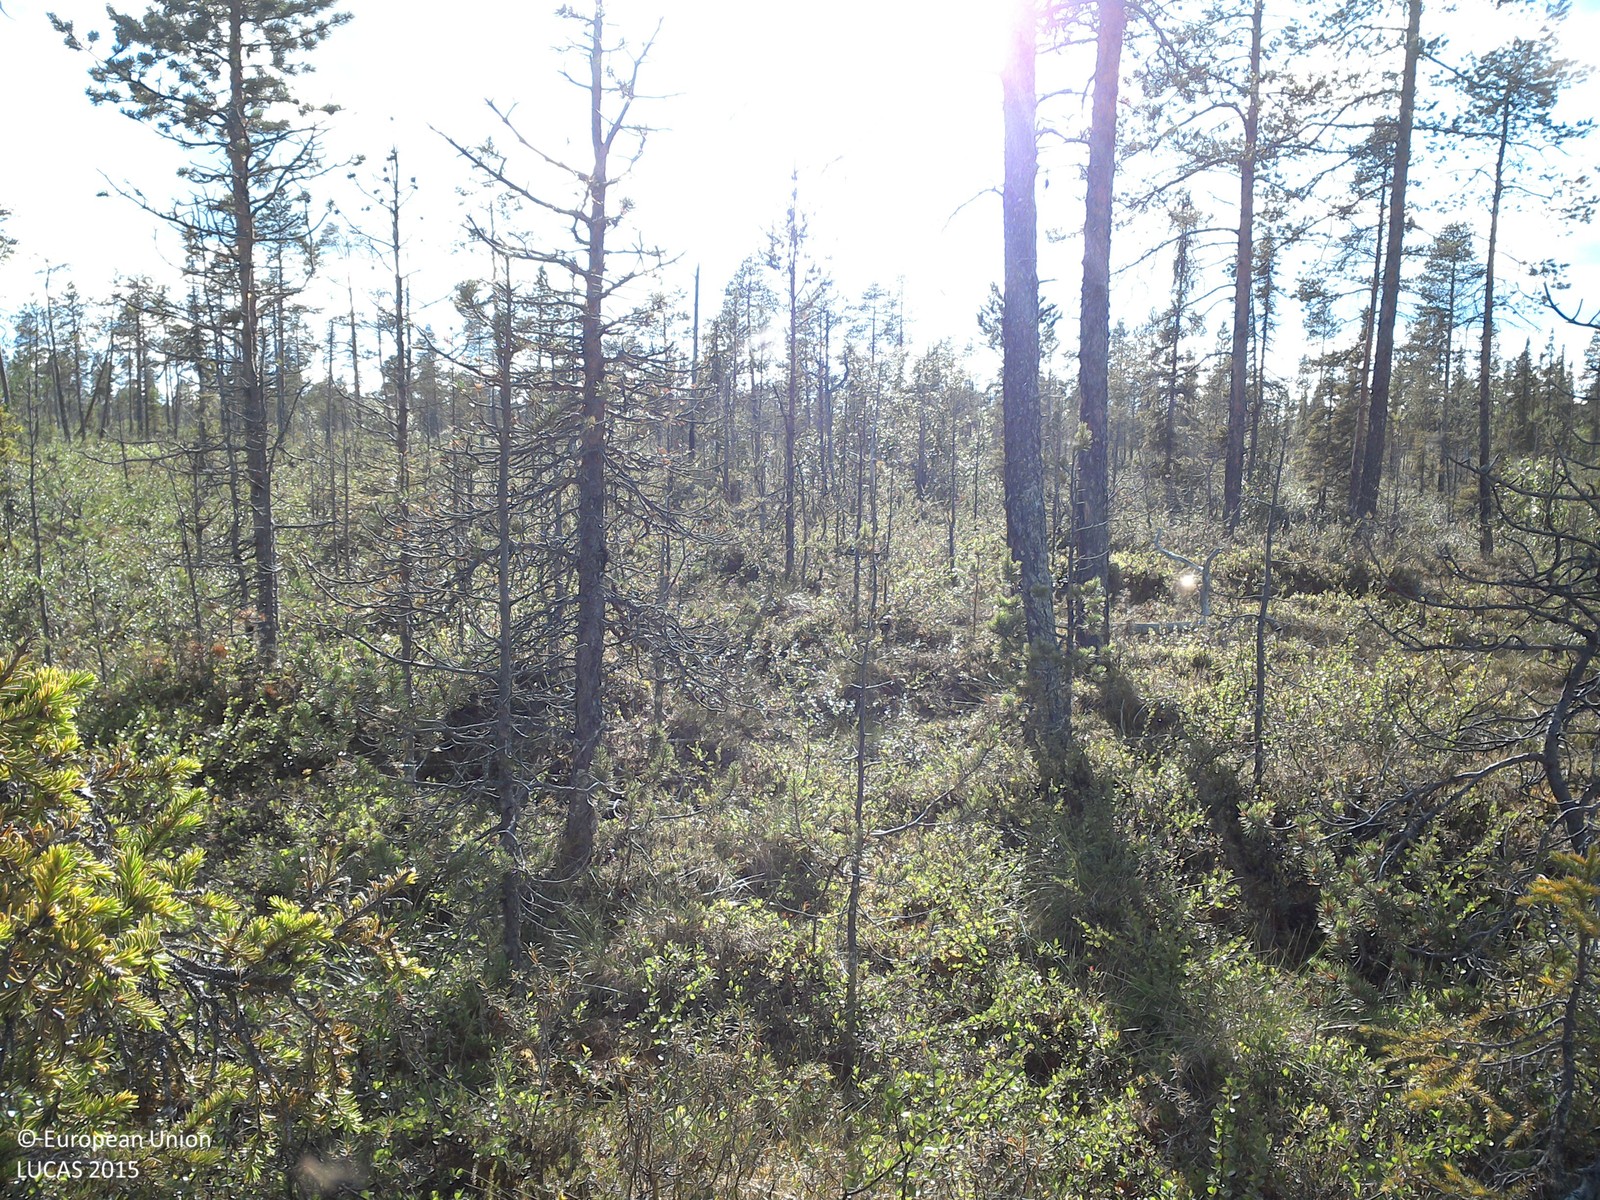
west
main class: Woodland
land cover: Pine dominated coniferous woodland
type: boreal forest
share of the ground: 10 - 25 %
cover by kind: shrubs 75 %, coniferous forest trees 15 %, lichens and mosses 10 %
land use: Semi-natural and natural areas not in use
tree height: > 5 m
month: July
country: SE
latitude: 67.7224
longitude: 21.1251
